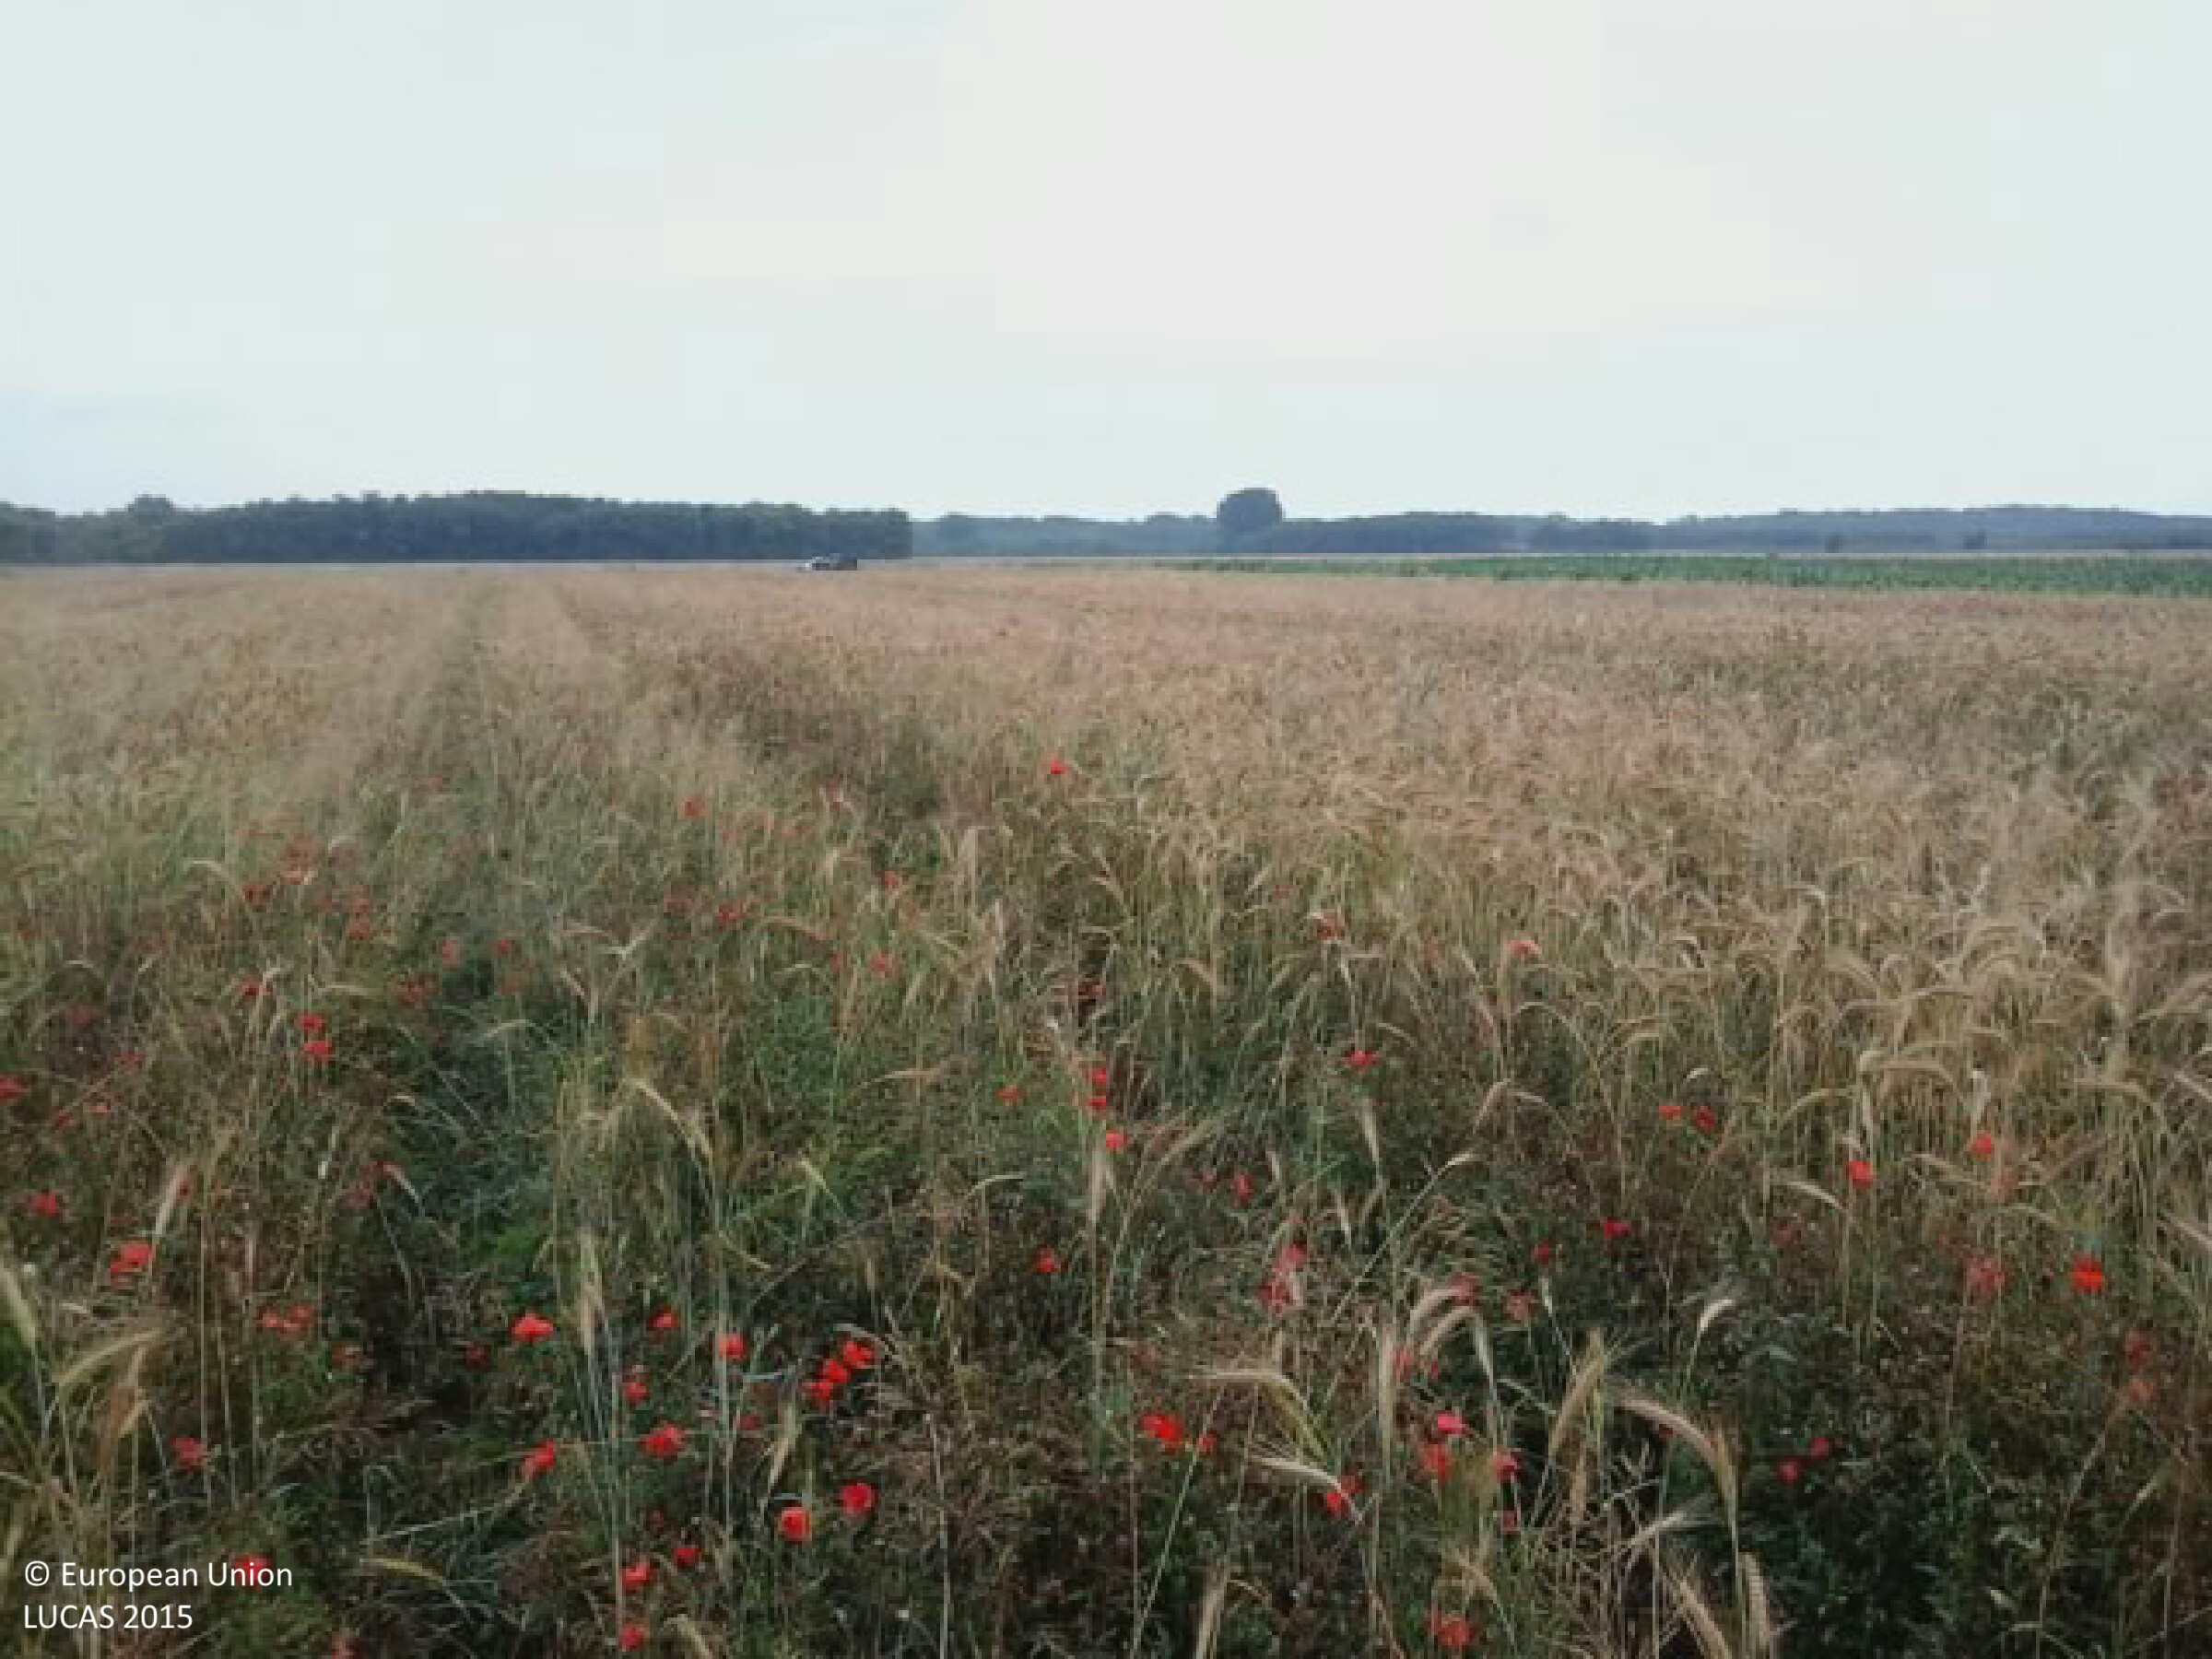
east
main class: Cropland
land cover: Common wheat
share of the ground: > 75 %
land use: Agriculture (excluding fallow land and kitchen gardens)
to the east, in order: Common wheat; Tracks; Grassland without tree/shrub cover
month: June
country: HU
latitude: 46.3980
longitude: 20.1018
